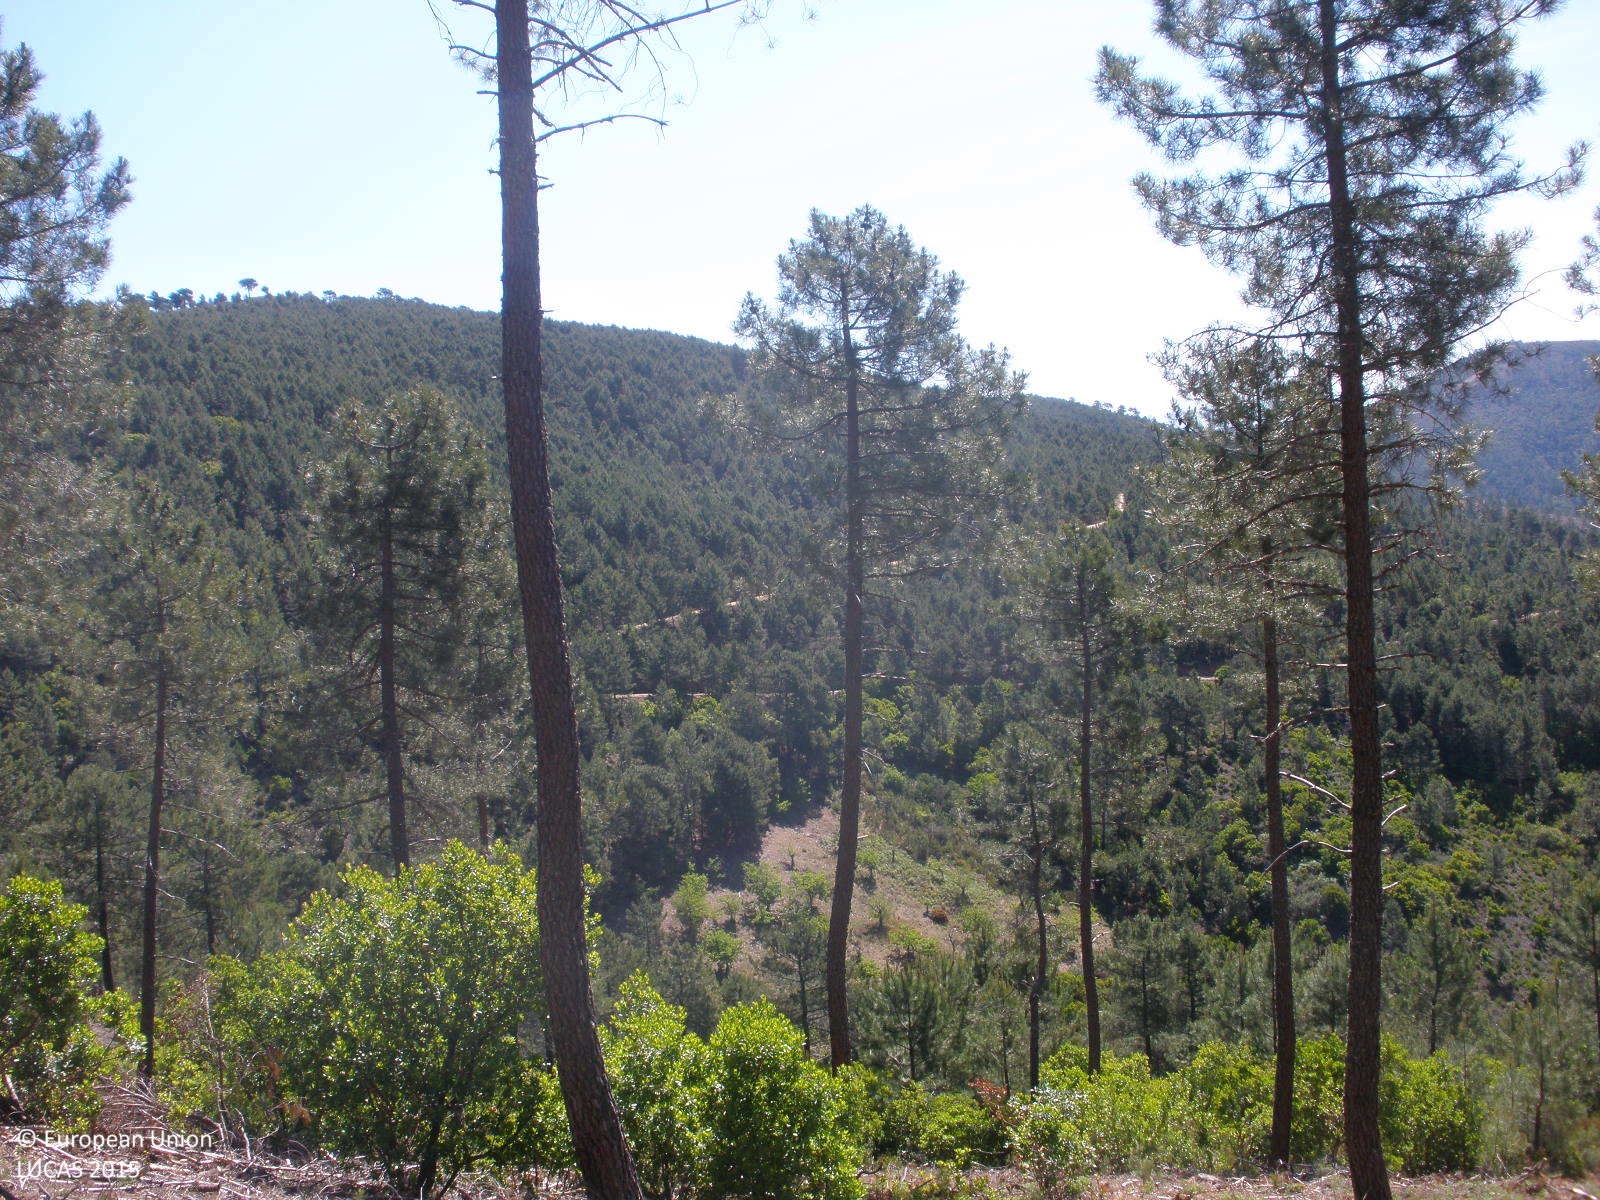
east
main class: Woodland
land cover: Pine dominated coniferous woodland
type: coniferous forest of the mediterranean region
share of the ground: > 75 %
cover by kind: coniferous forest trees 40 %, shrubs 30 %, consolidated bare surface 30 %
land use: Forestry
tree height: > 5 m
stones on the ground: < 10 %
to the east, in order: Pine dominated coniferous woodland; Permanent crops (only in case pi); Pine dominated coniferous woodland
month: May
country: ES
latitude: 40.4492
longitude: -6.2466
